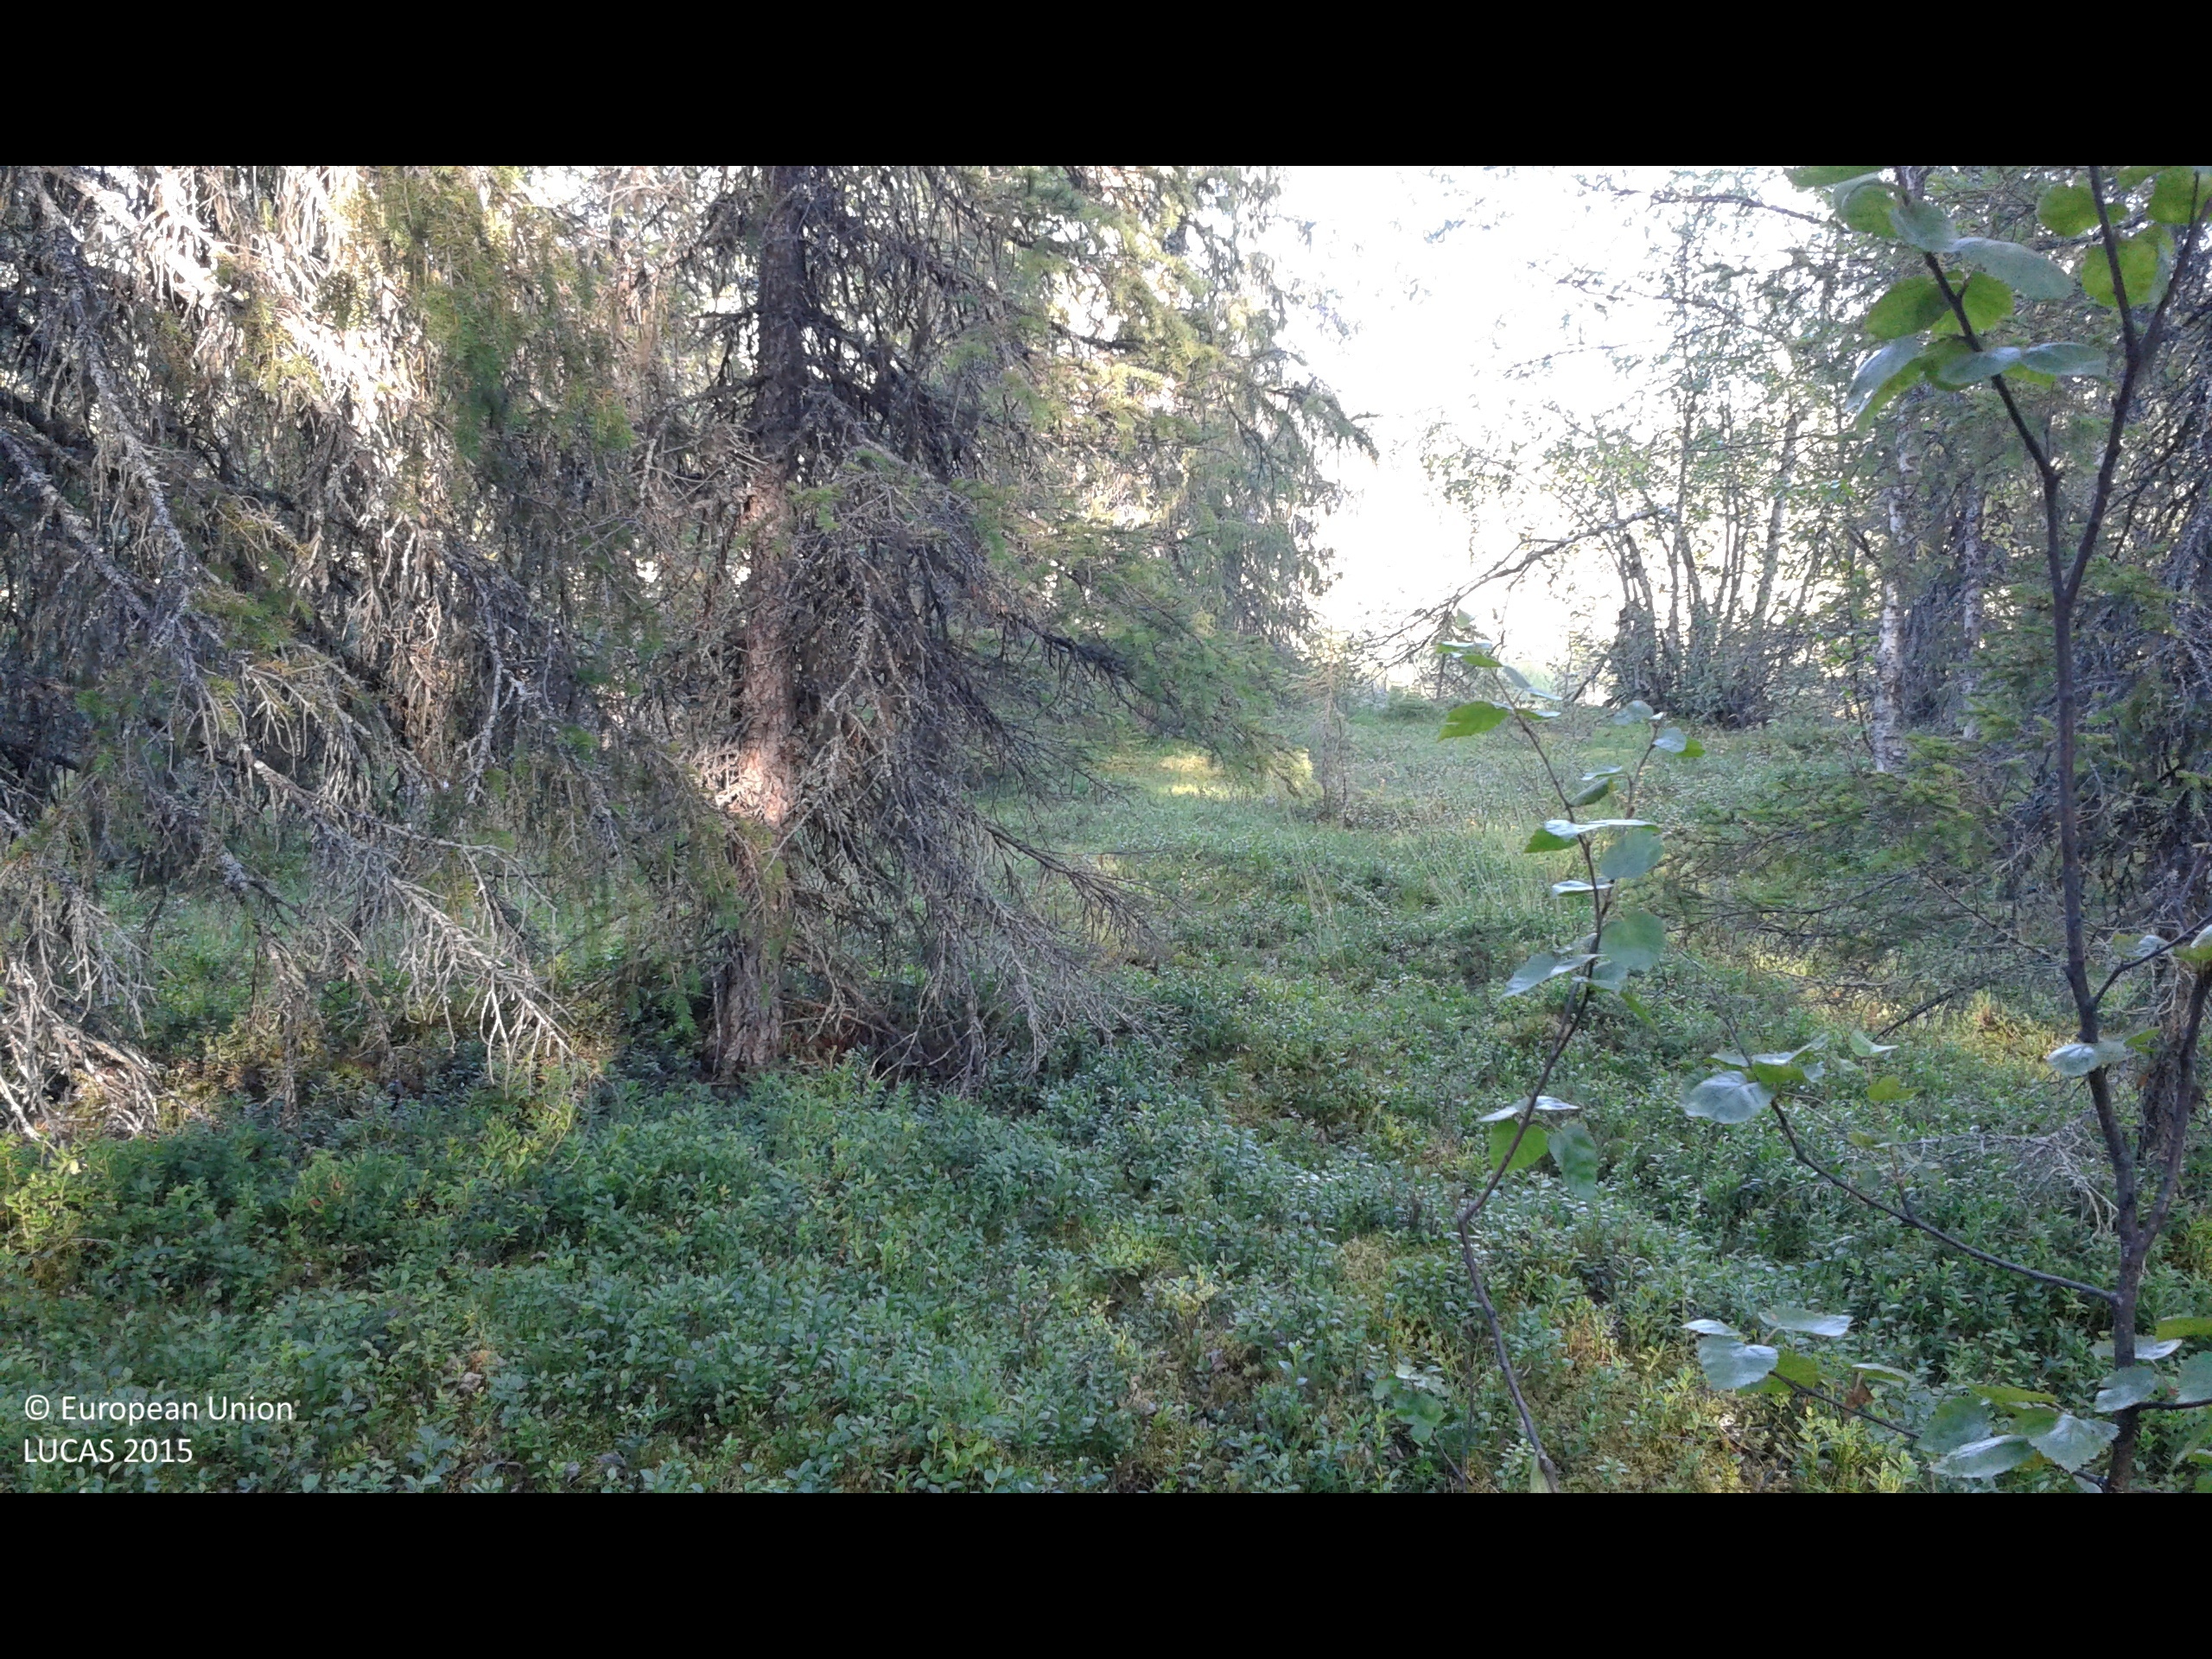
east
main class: Woodland
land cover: Spruce dominated mixed woodland
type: boreal forest
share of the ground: 25 - 50 %
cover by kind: shrubs 50 %, coniferous forest trees 25 %, lichens and mosses 15 %, broadleaved forest trees 10 %
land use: Forestry
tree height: > 5 m
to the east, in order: Spruce dominated mixed woodland; Inland marshes; Rivers and streams; Inland marshes; Groves; Tracks; Groves; Peatbogs; Pine dominated mixed woodland; Broadleaved woodland; Spruce dominated mixed woodland
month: August
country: SE
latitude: 67.3158
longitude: 21.1731
